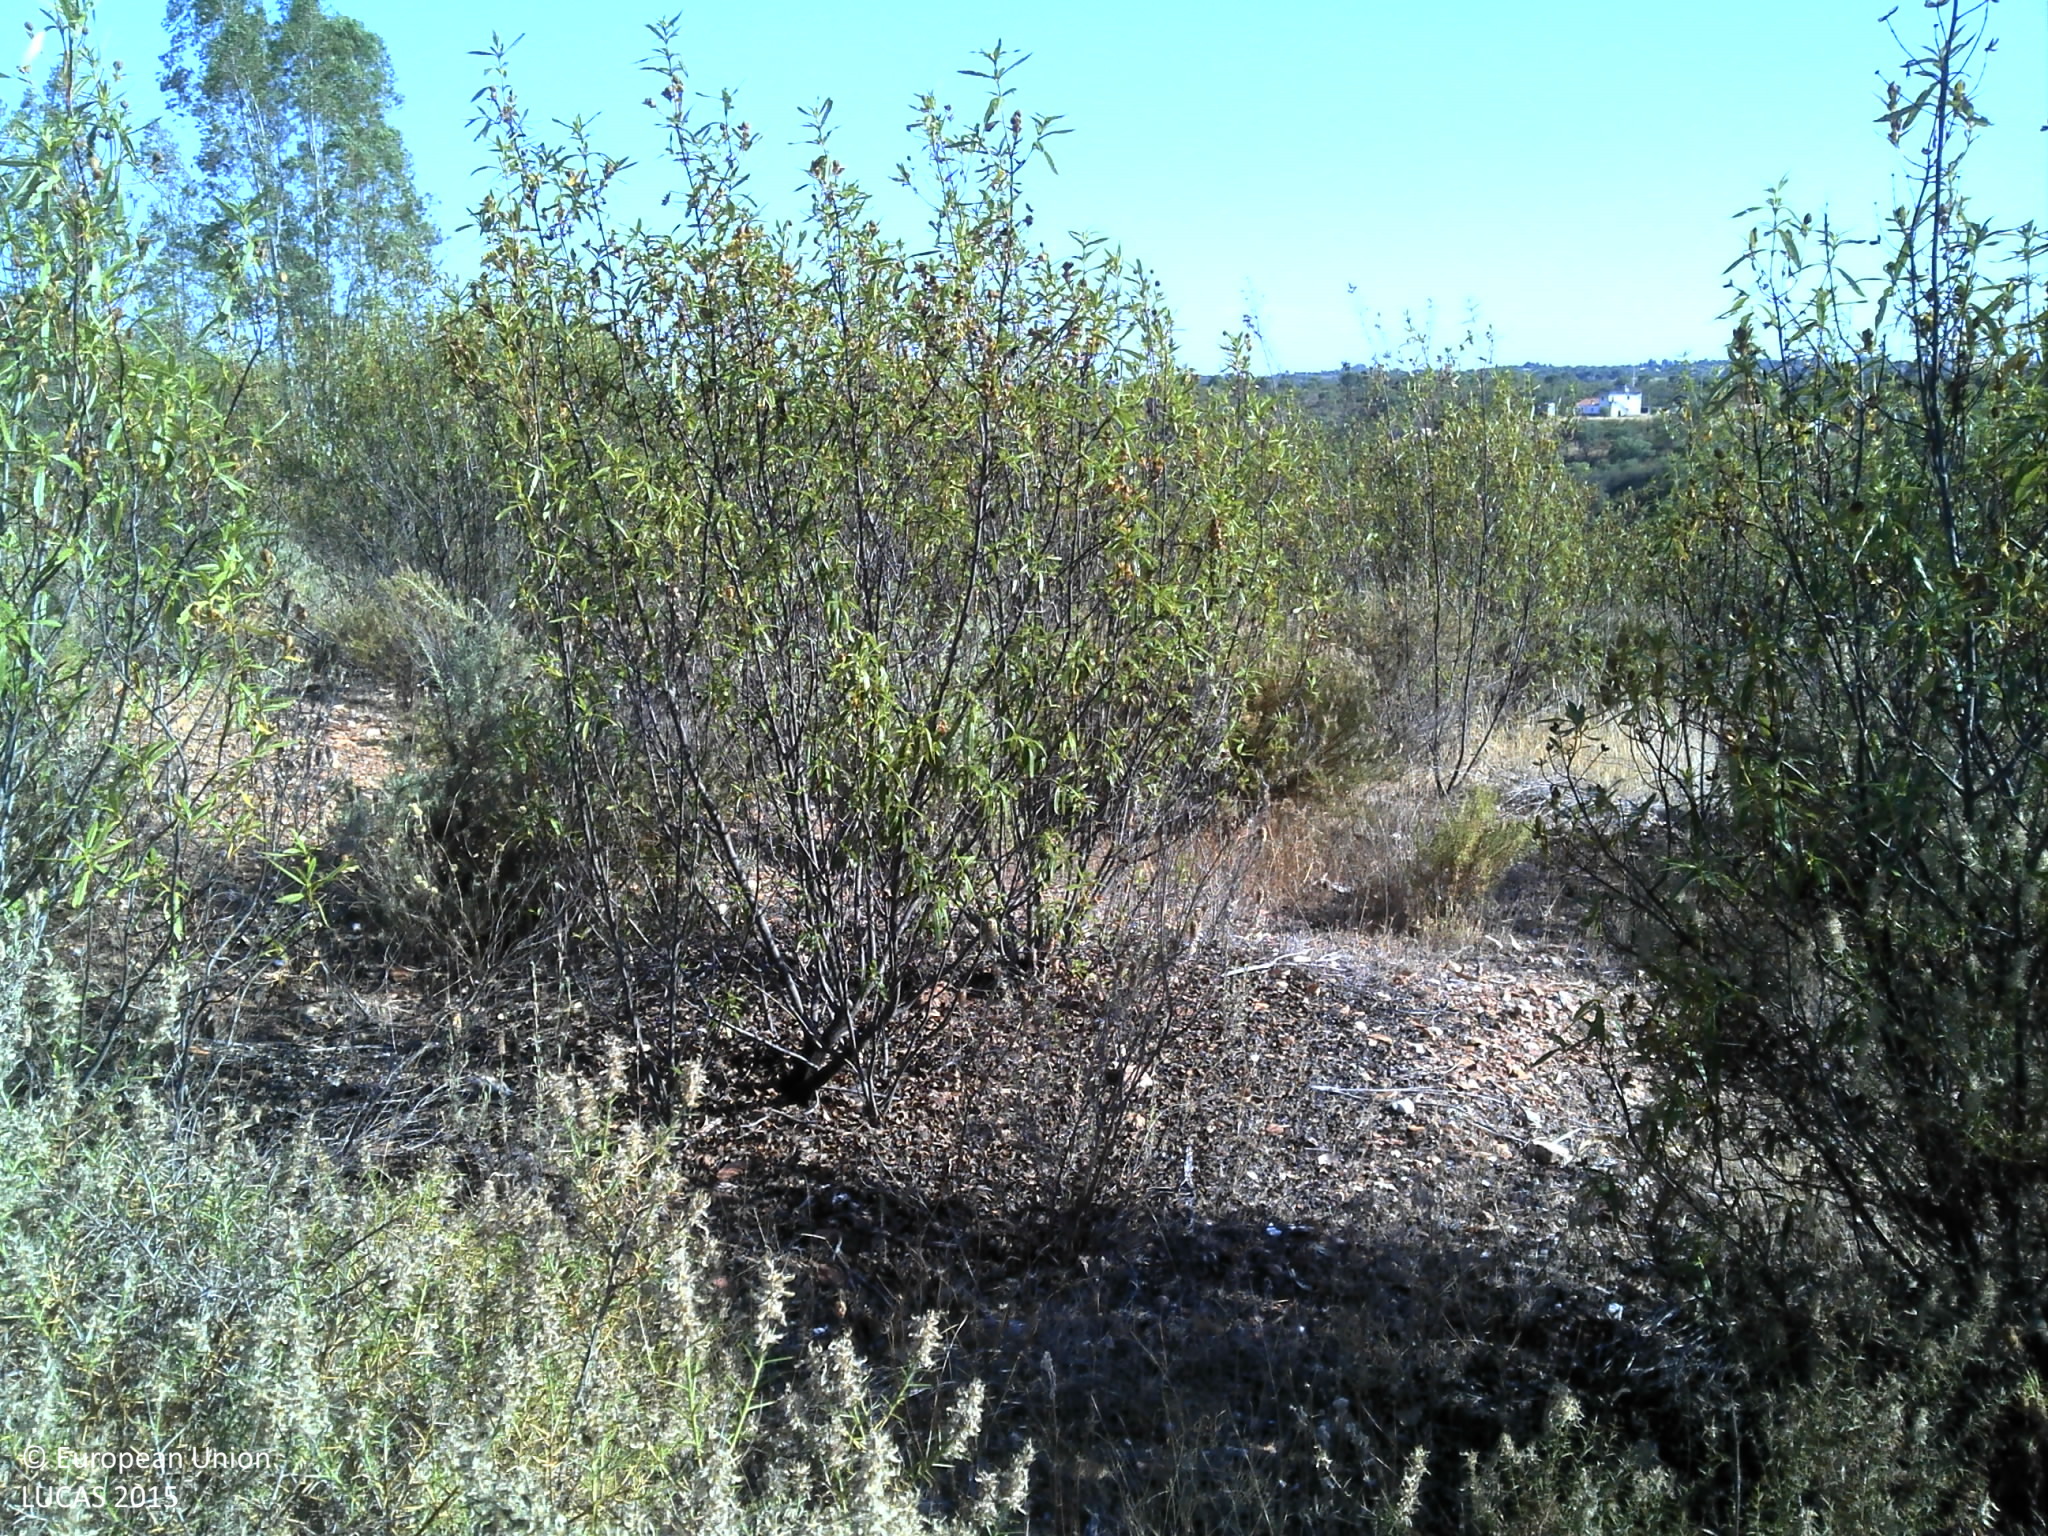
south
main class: Shrubland
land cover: Shrubland with sparse tree cover
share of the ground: > 75 %
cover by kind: shrubs 90 %, broadleaved forest trees 5 %, unconsolidated bare surface 5 %
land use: Abandoned areas
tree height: < 5 m
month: June
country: PT
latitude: 37.9068
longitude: -7.2892
